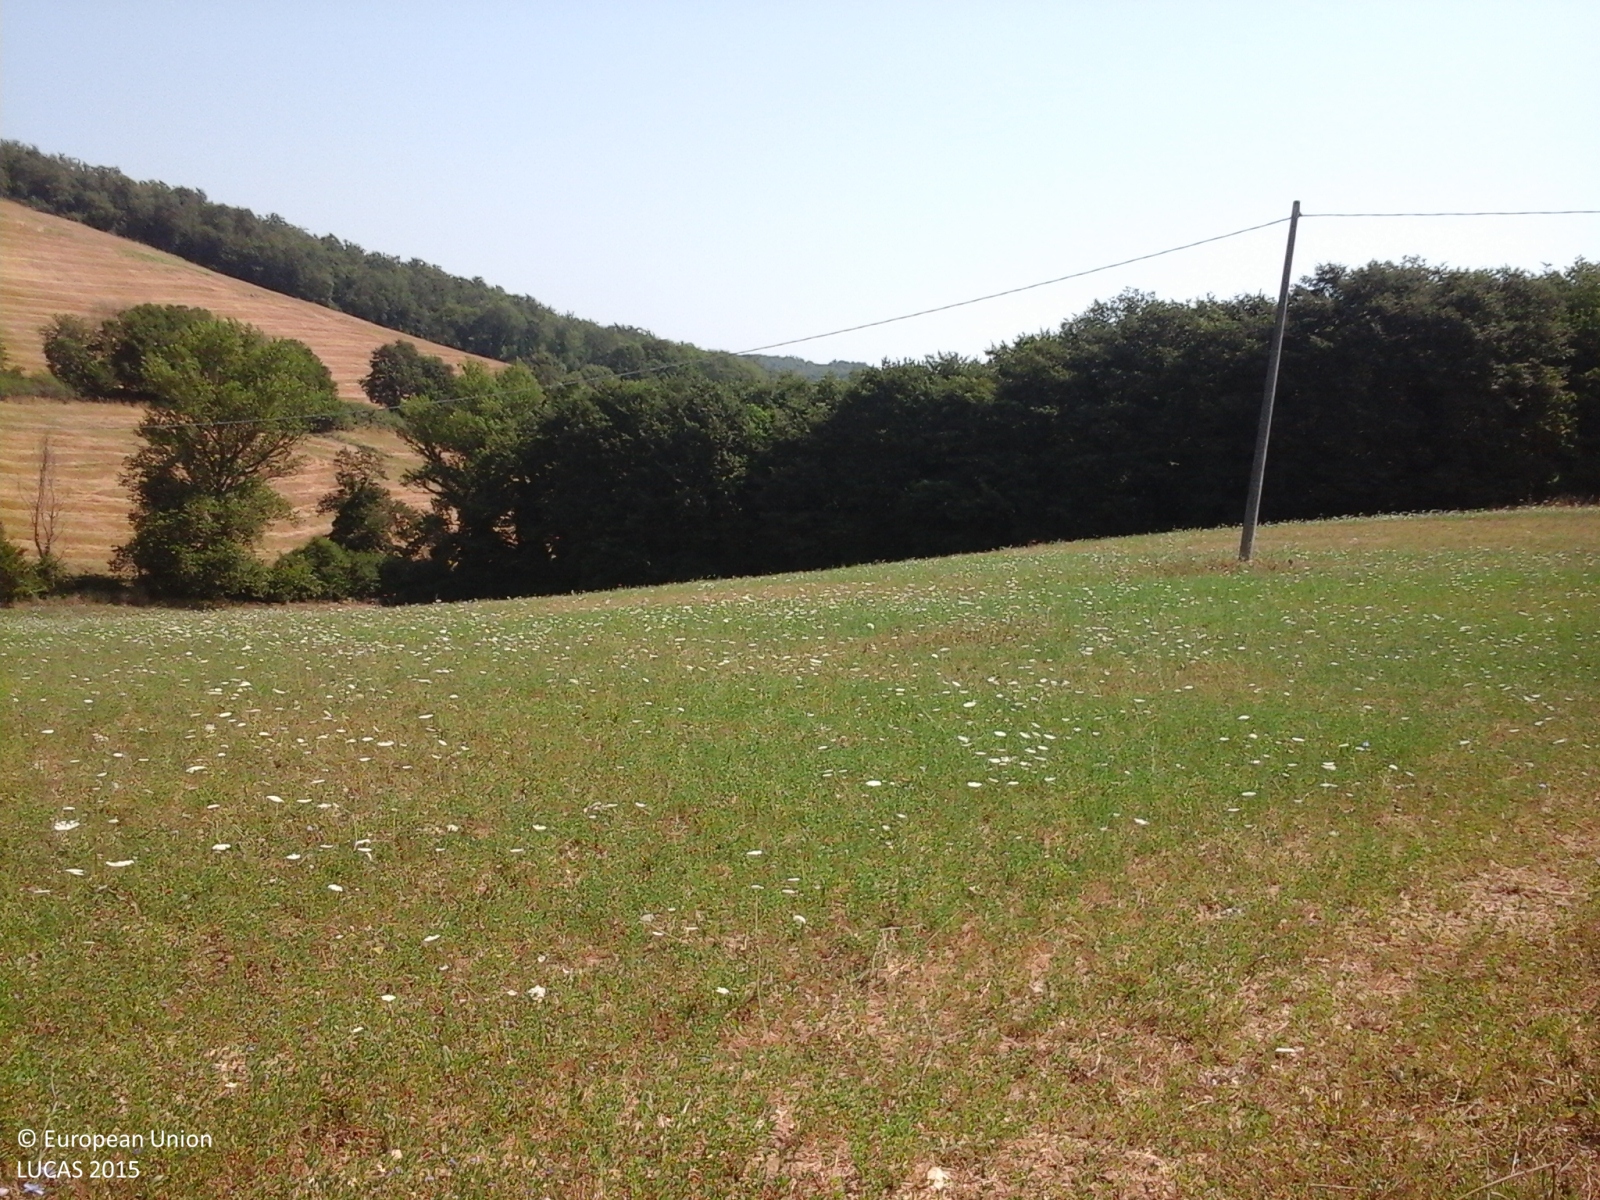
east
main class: Cropland
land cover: Lucerne
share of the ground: > 75 %
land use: Agriculture (excluding fallow land and kitchen gardens)
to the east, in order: Lucerne; Broadleaved woodland
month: July
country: IT
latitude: 43.3526
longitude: 11.0703
